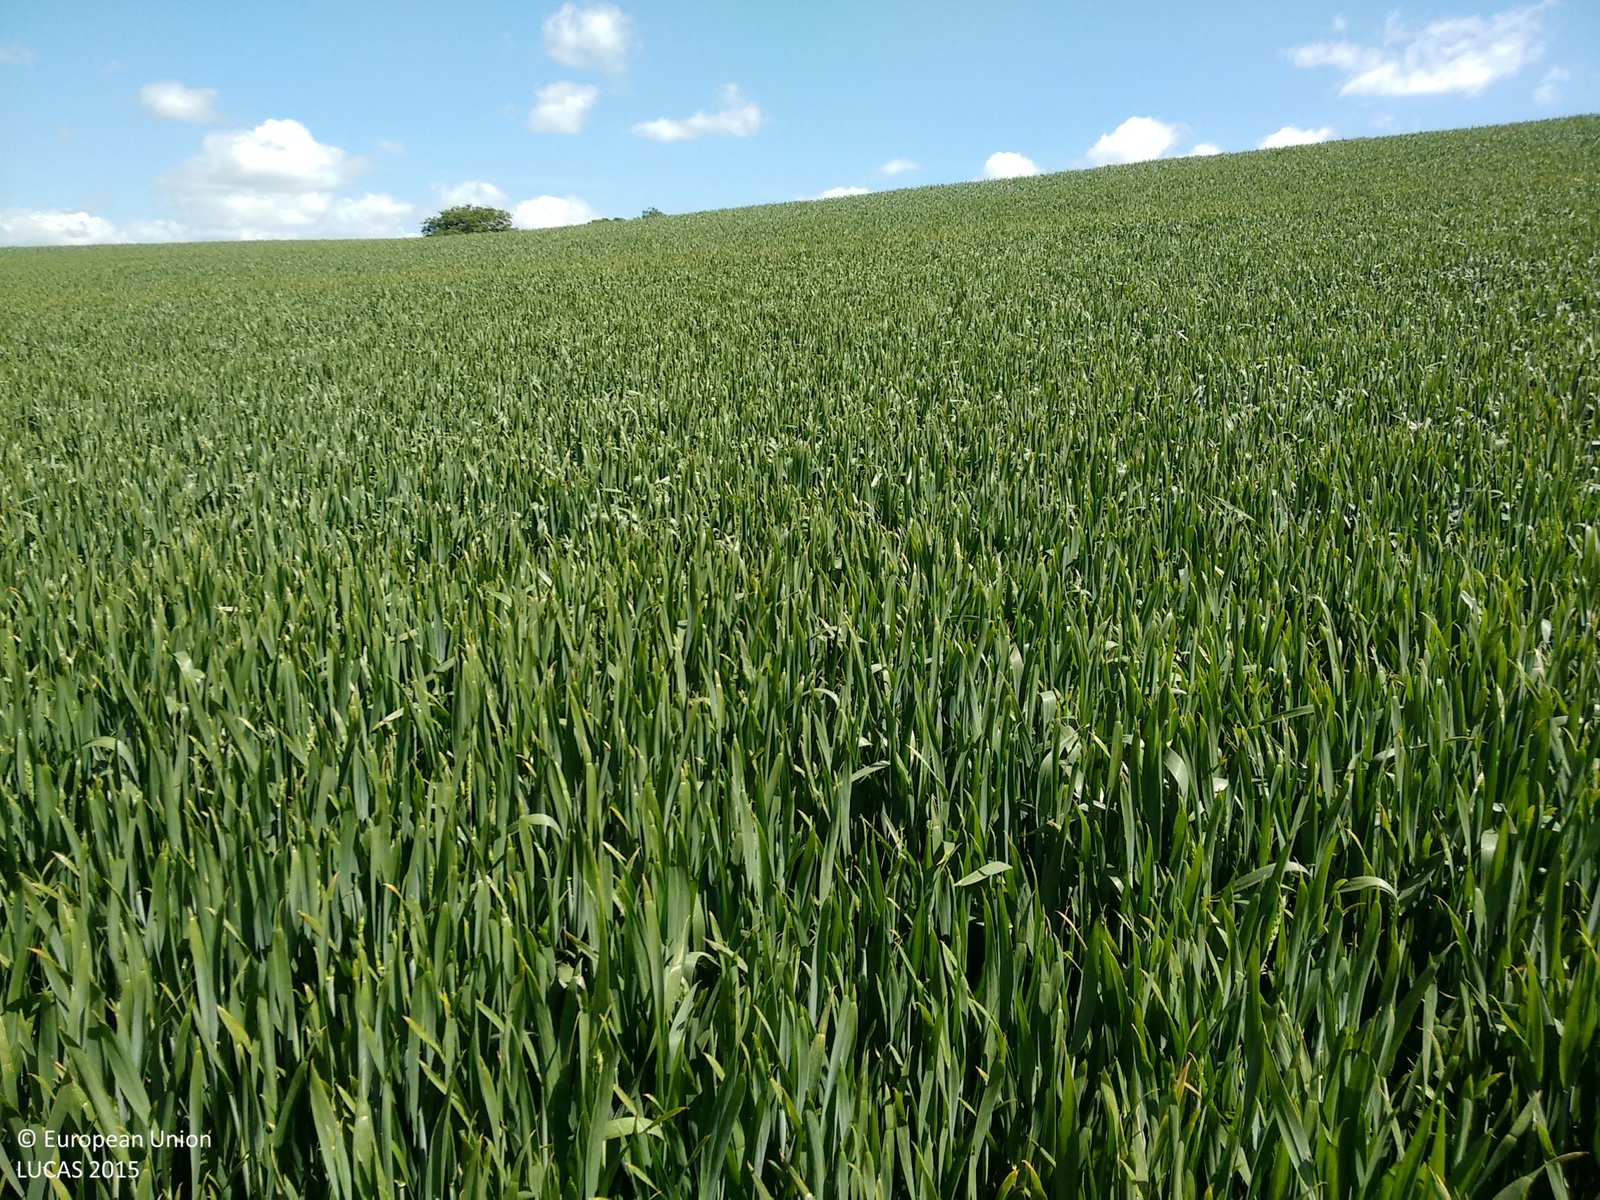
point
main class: Cropland
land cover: Barley
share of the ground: > 75 %
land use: Agriculture (excluding fallow land and kitchen gardens)
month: June
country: GB
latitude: 54.1880
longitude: -1.5899
